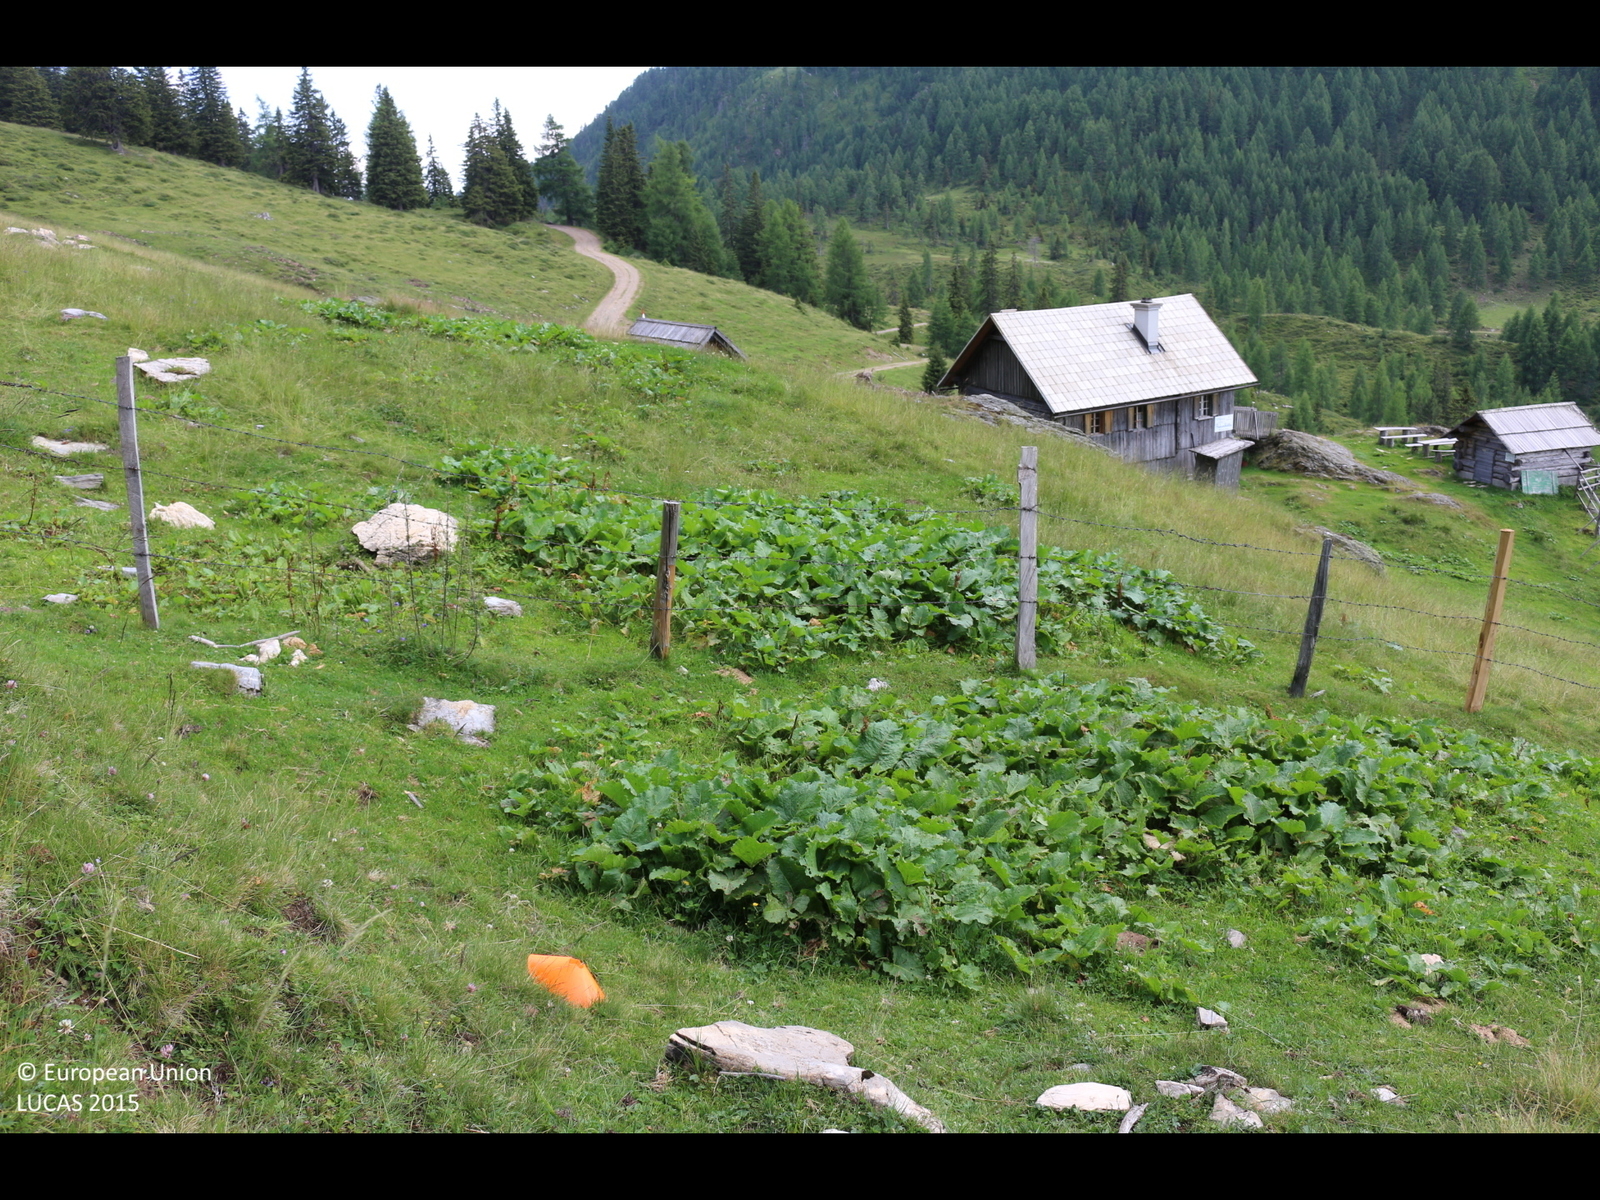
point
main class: Grassland
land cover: Grassland without tree/shrub cover
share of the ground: > 75 %
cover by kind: herbaceous plants 100 %
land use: Agriculture (excluding fallow land and kitchen gardens)
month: July
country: AT
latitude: 46.7466
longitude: 13.4399
